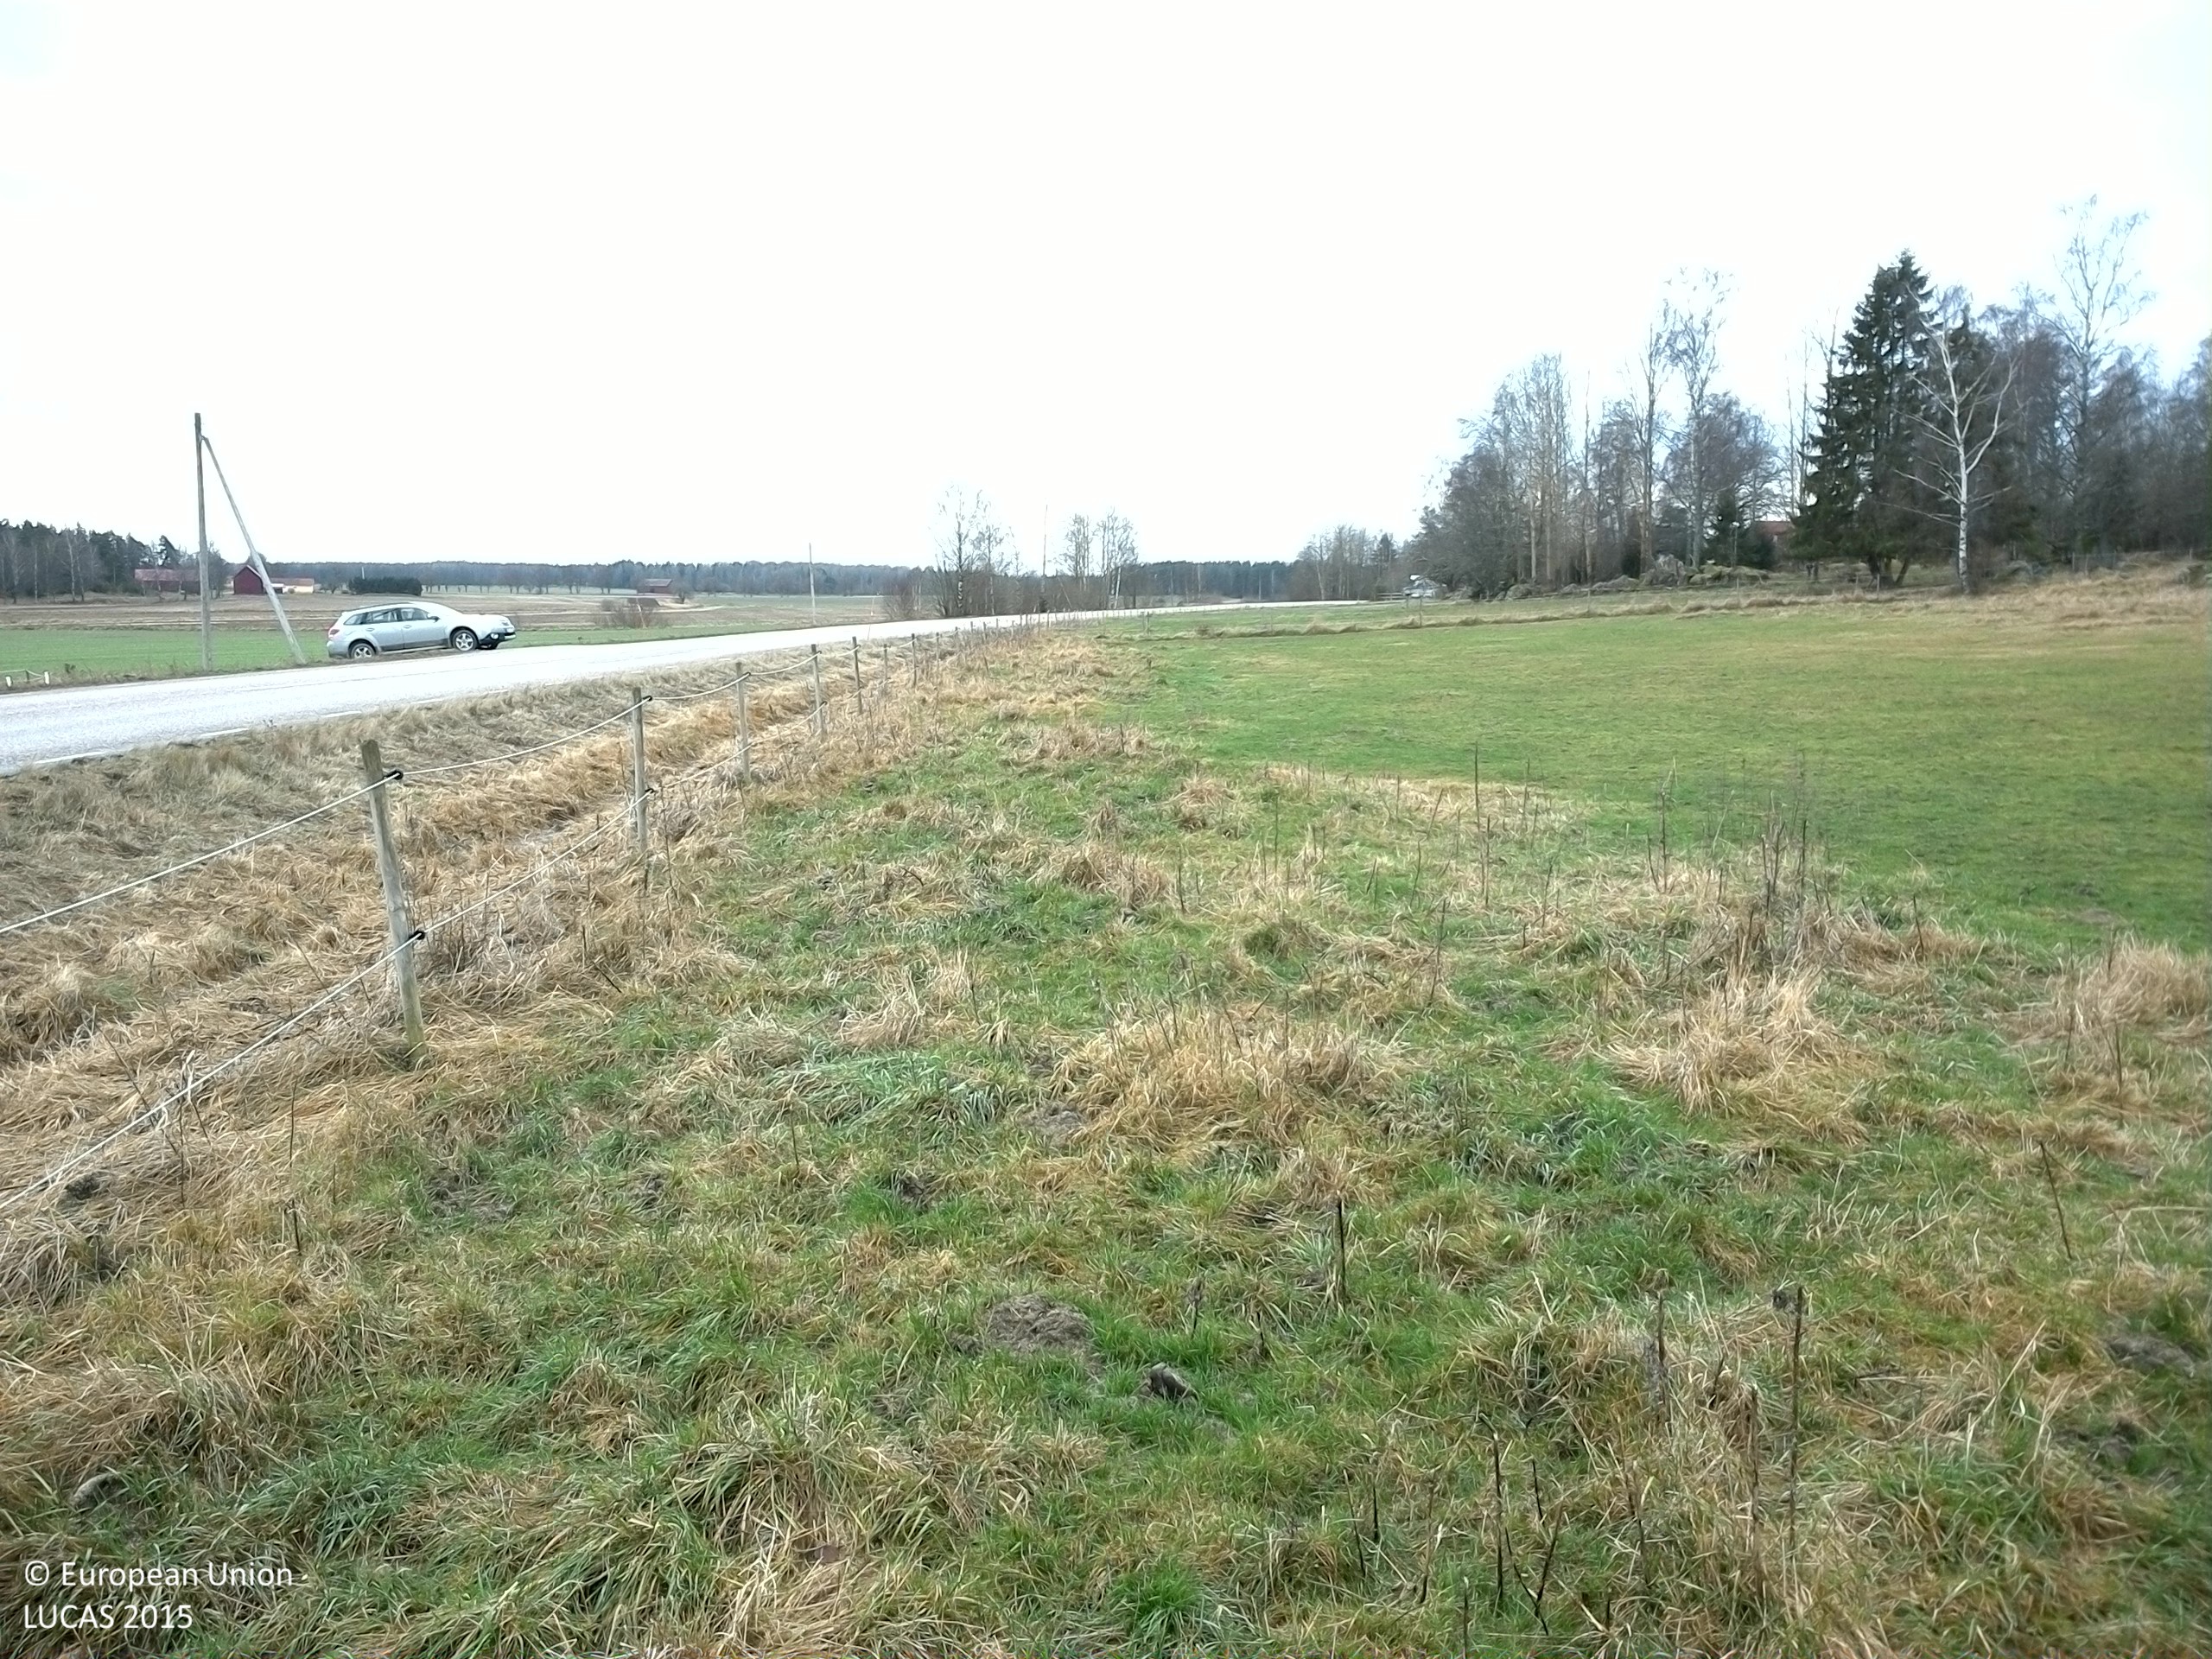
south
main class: Grassland
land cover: Grassland without tree/shrub cover
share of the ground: > 75 %
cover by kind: herbaceous plants 100 %
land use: Agriculture (excluding fallow land and kitchen gardens)
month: December
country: SE
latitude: 59.6429
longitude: 16.6801
